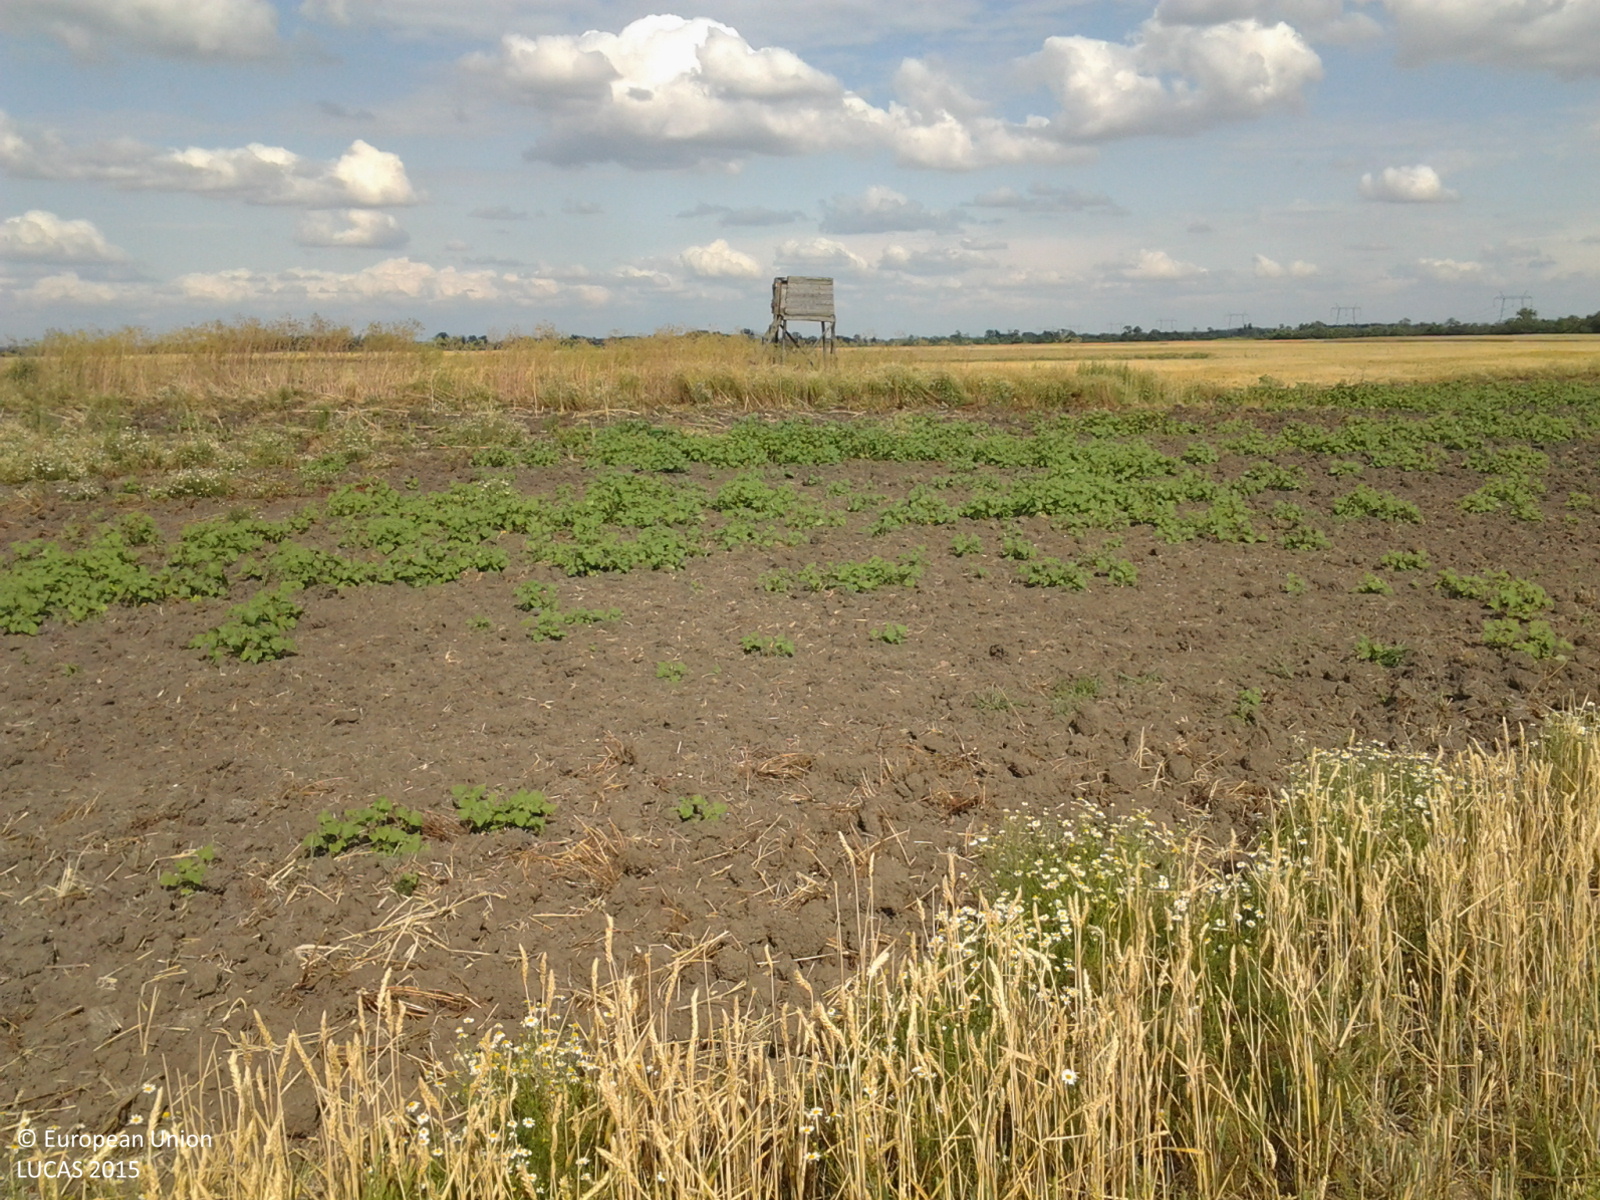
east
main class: Cropland
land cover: Common wheat
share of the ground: 25 - 50 %
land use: Agriculture (excluding fallow land and kitchen gardens)
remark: Harvested field
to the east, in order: Common wheat; Spontaneously vegetated surfaces; Shruby margins; Ditches and canals; Shruby margins; Rye
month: July
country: HU
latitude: 47.2964
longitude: 20.3836
